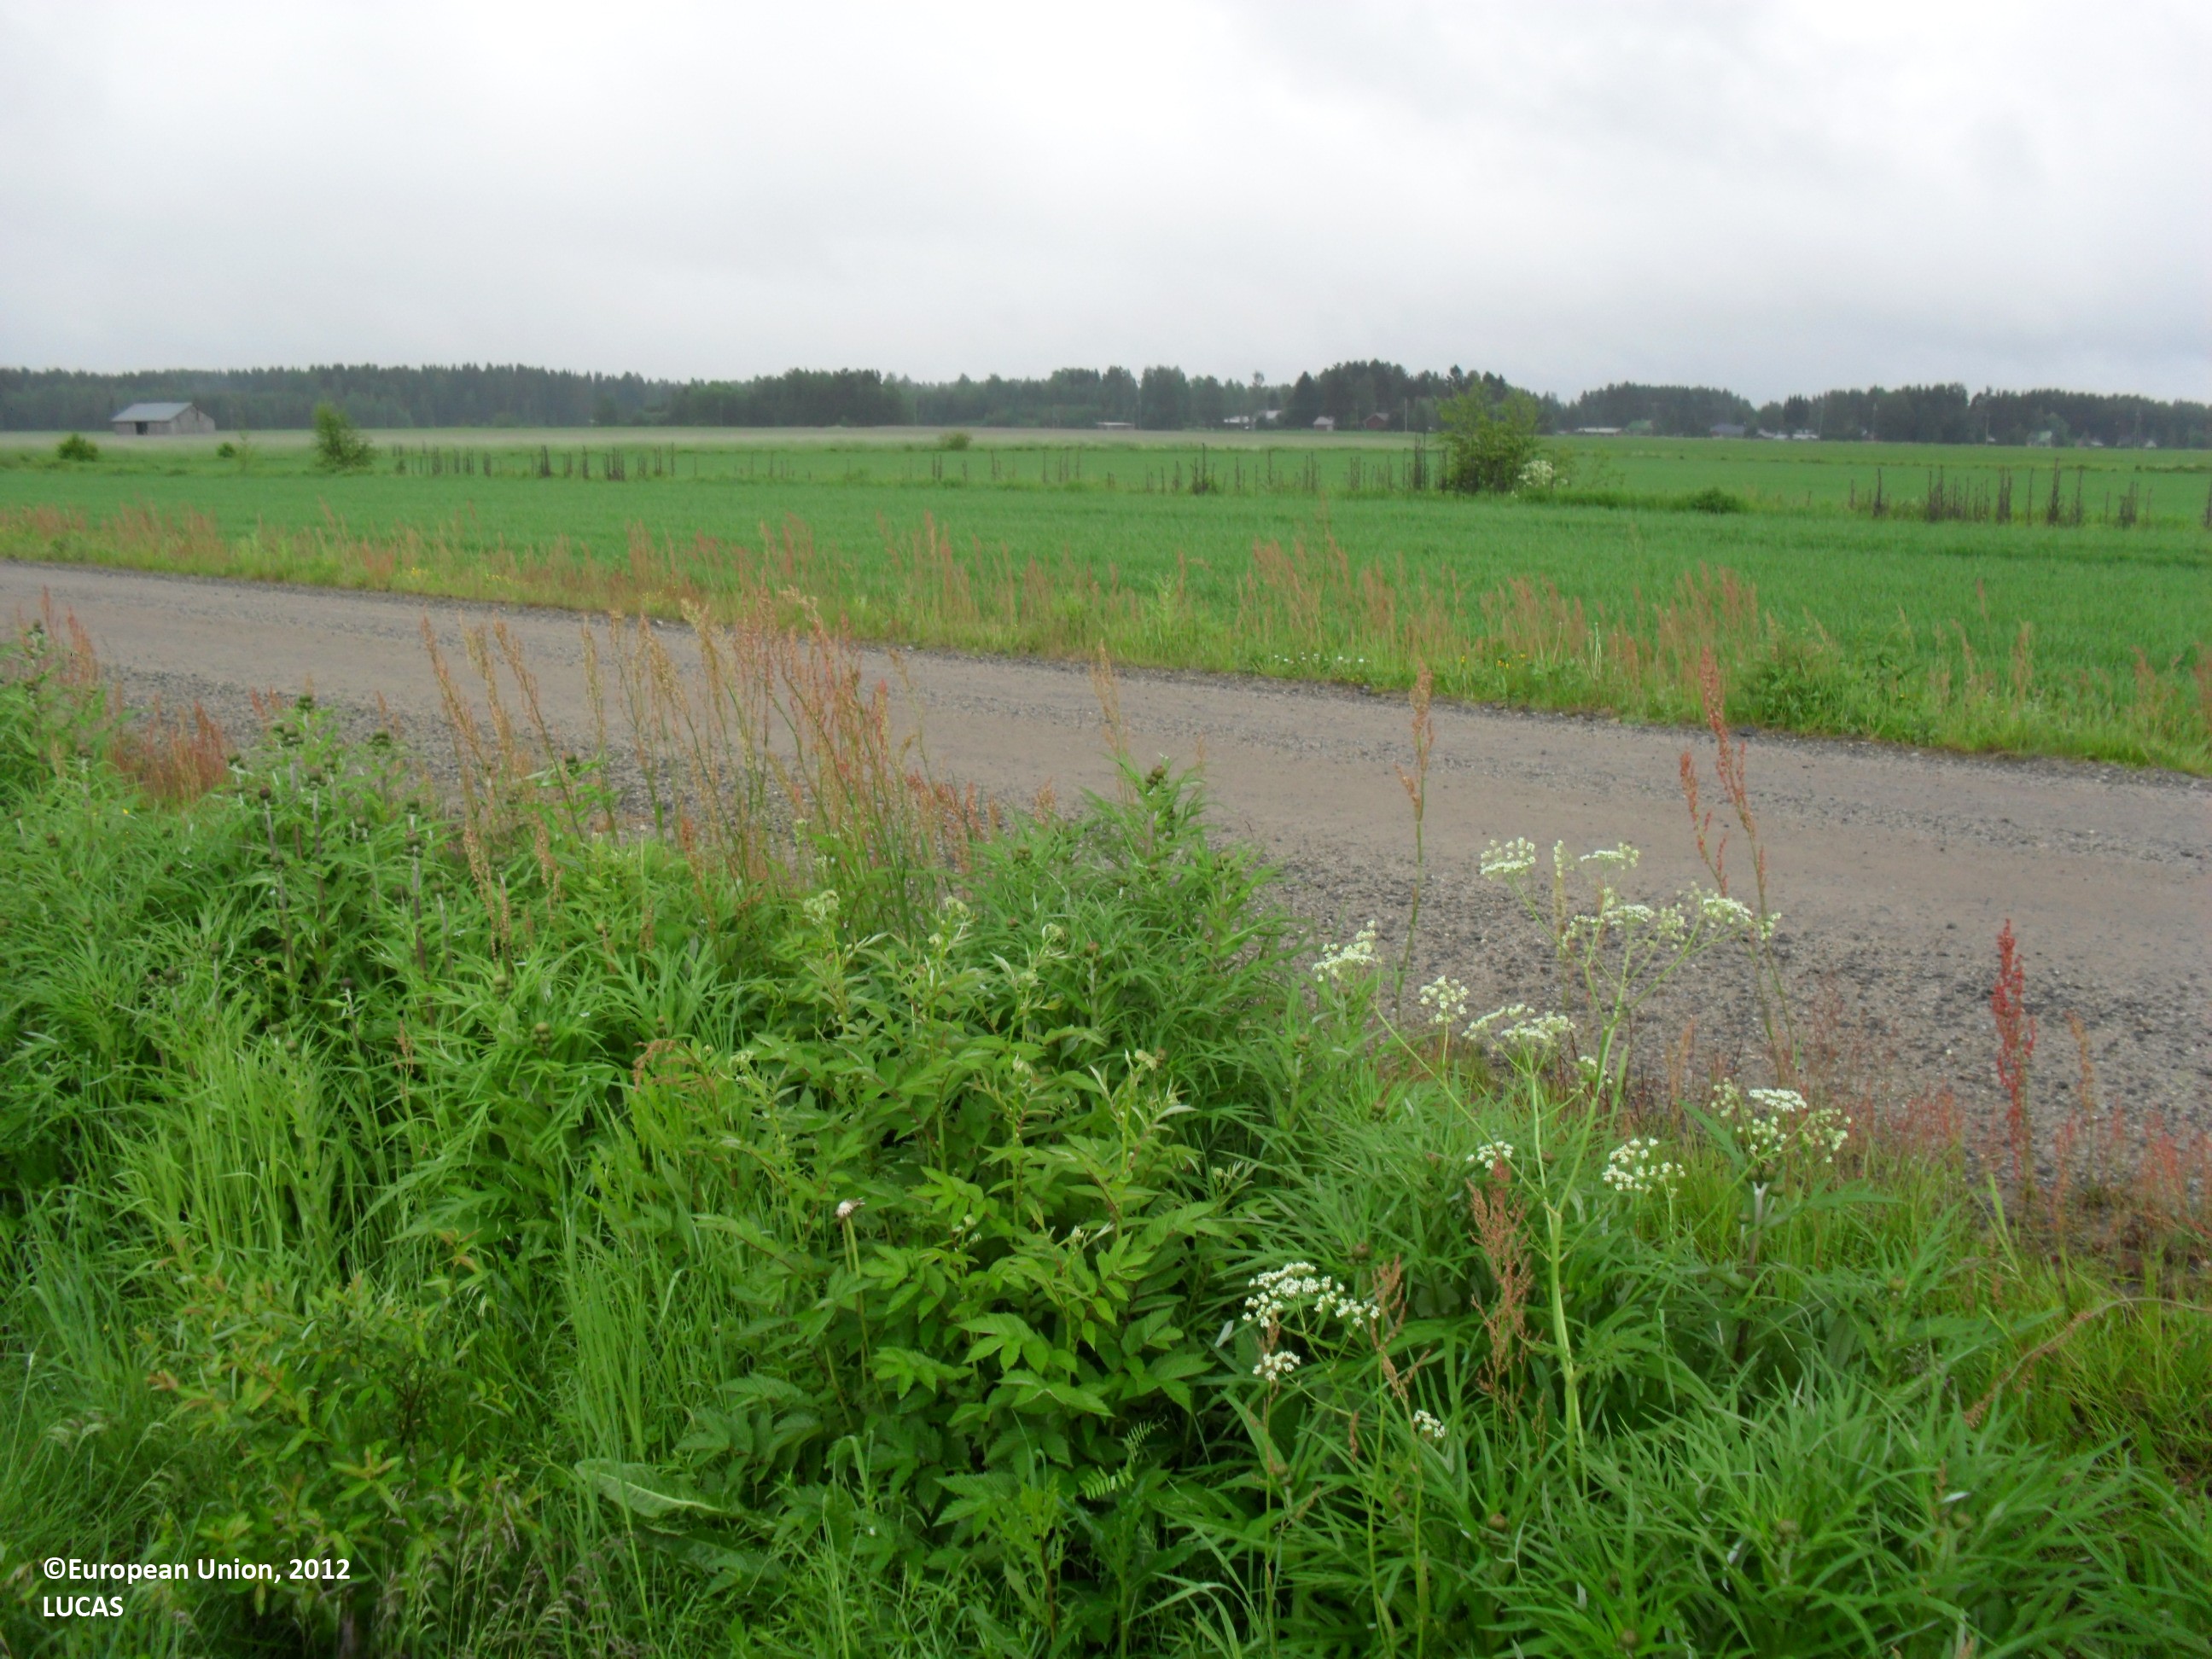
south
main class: Cropland
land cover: Barley
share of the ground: 25 - 50 %
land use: Agriculture (excluding fallow land and kitchen gardens)
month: June
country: FI
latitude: 63.0988
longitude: 23.1148
